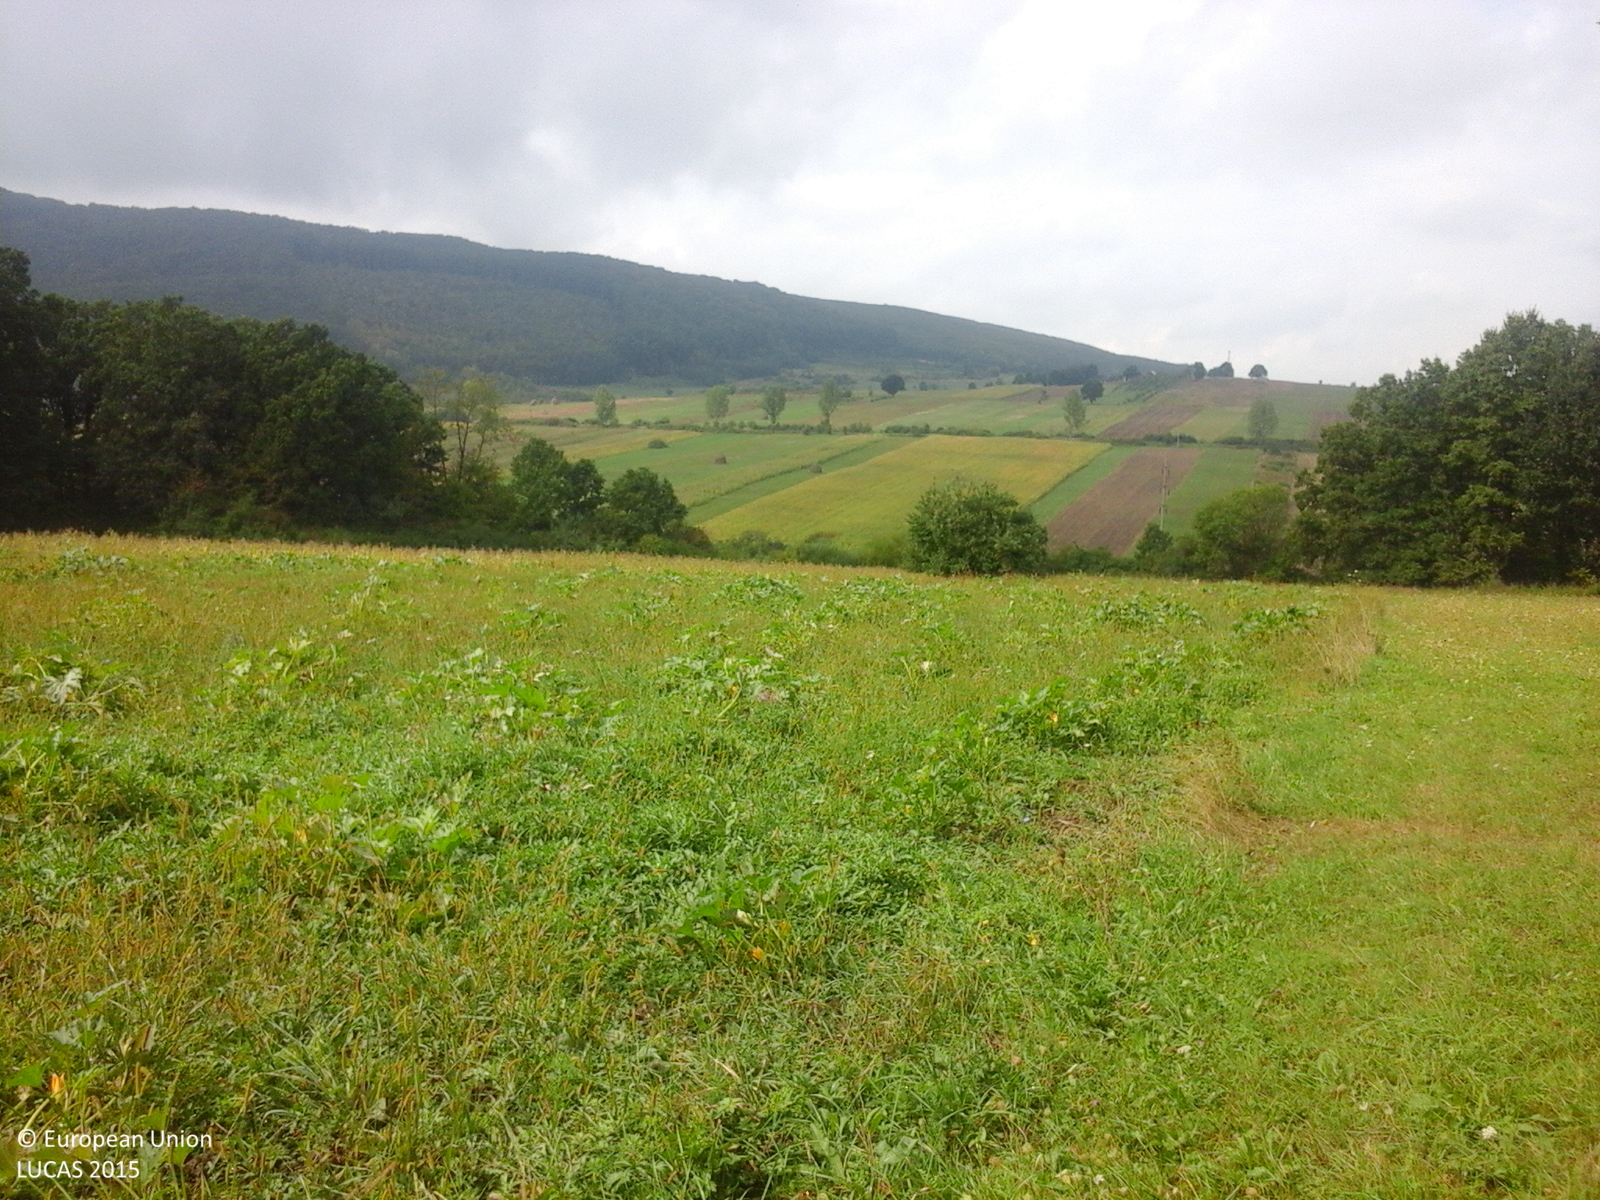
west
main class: Grassland
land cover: Grassland without tree/shrub cover
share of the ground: > 75 %
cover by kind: herbaceous plants 100 %
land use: Agriculture (excluding fallow land and kitchen gardens)
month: September
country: RO
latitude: 46.9565
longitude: 22.5514
